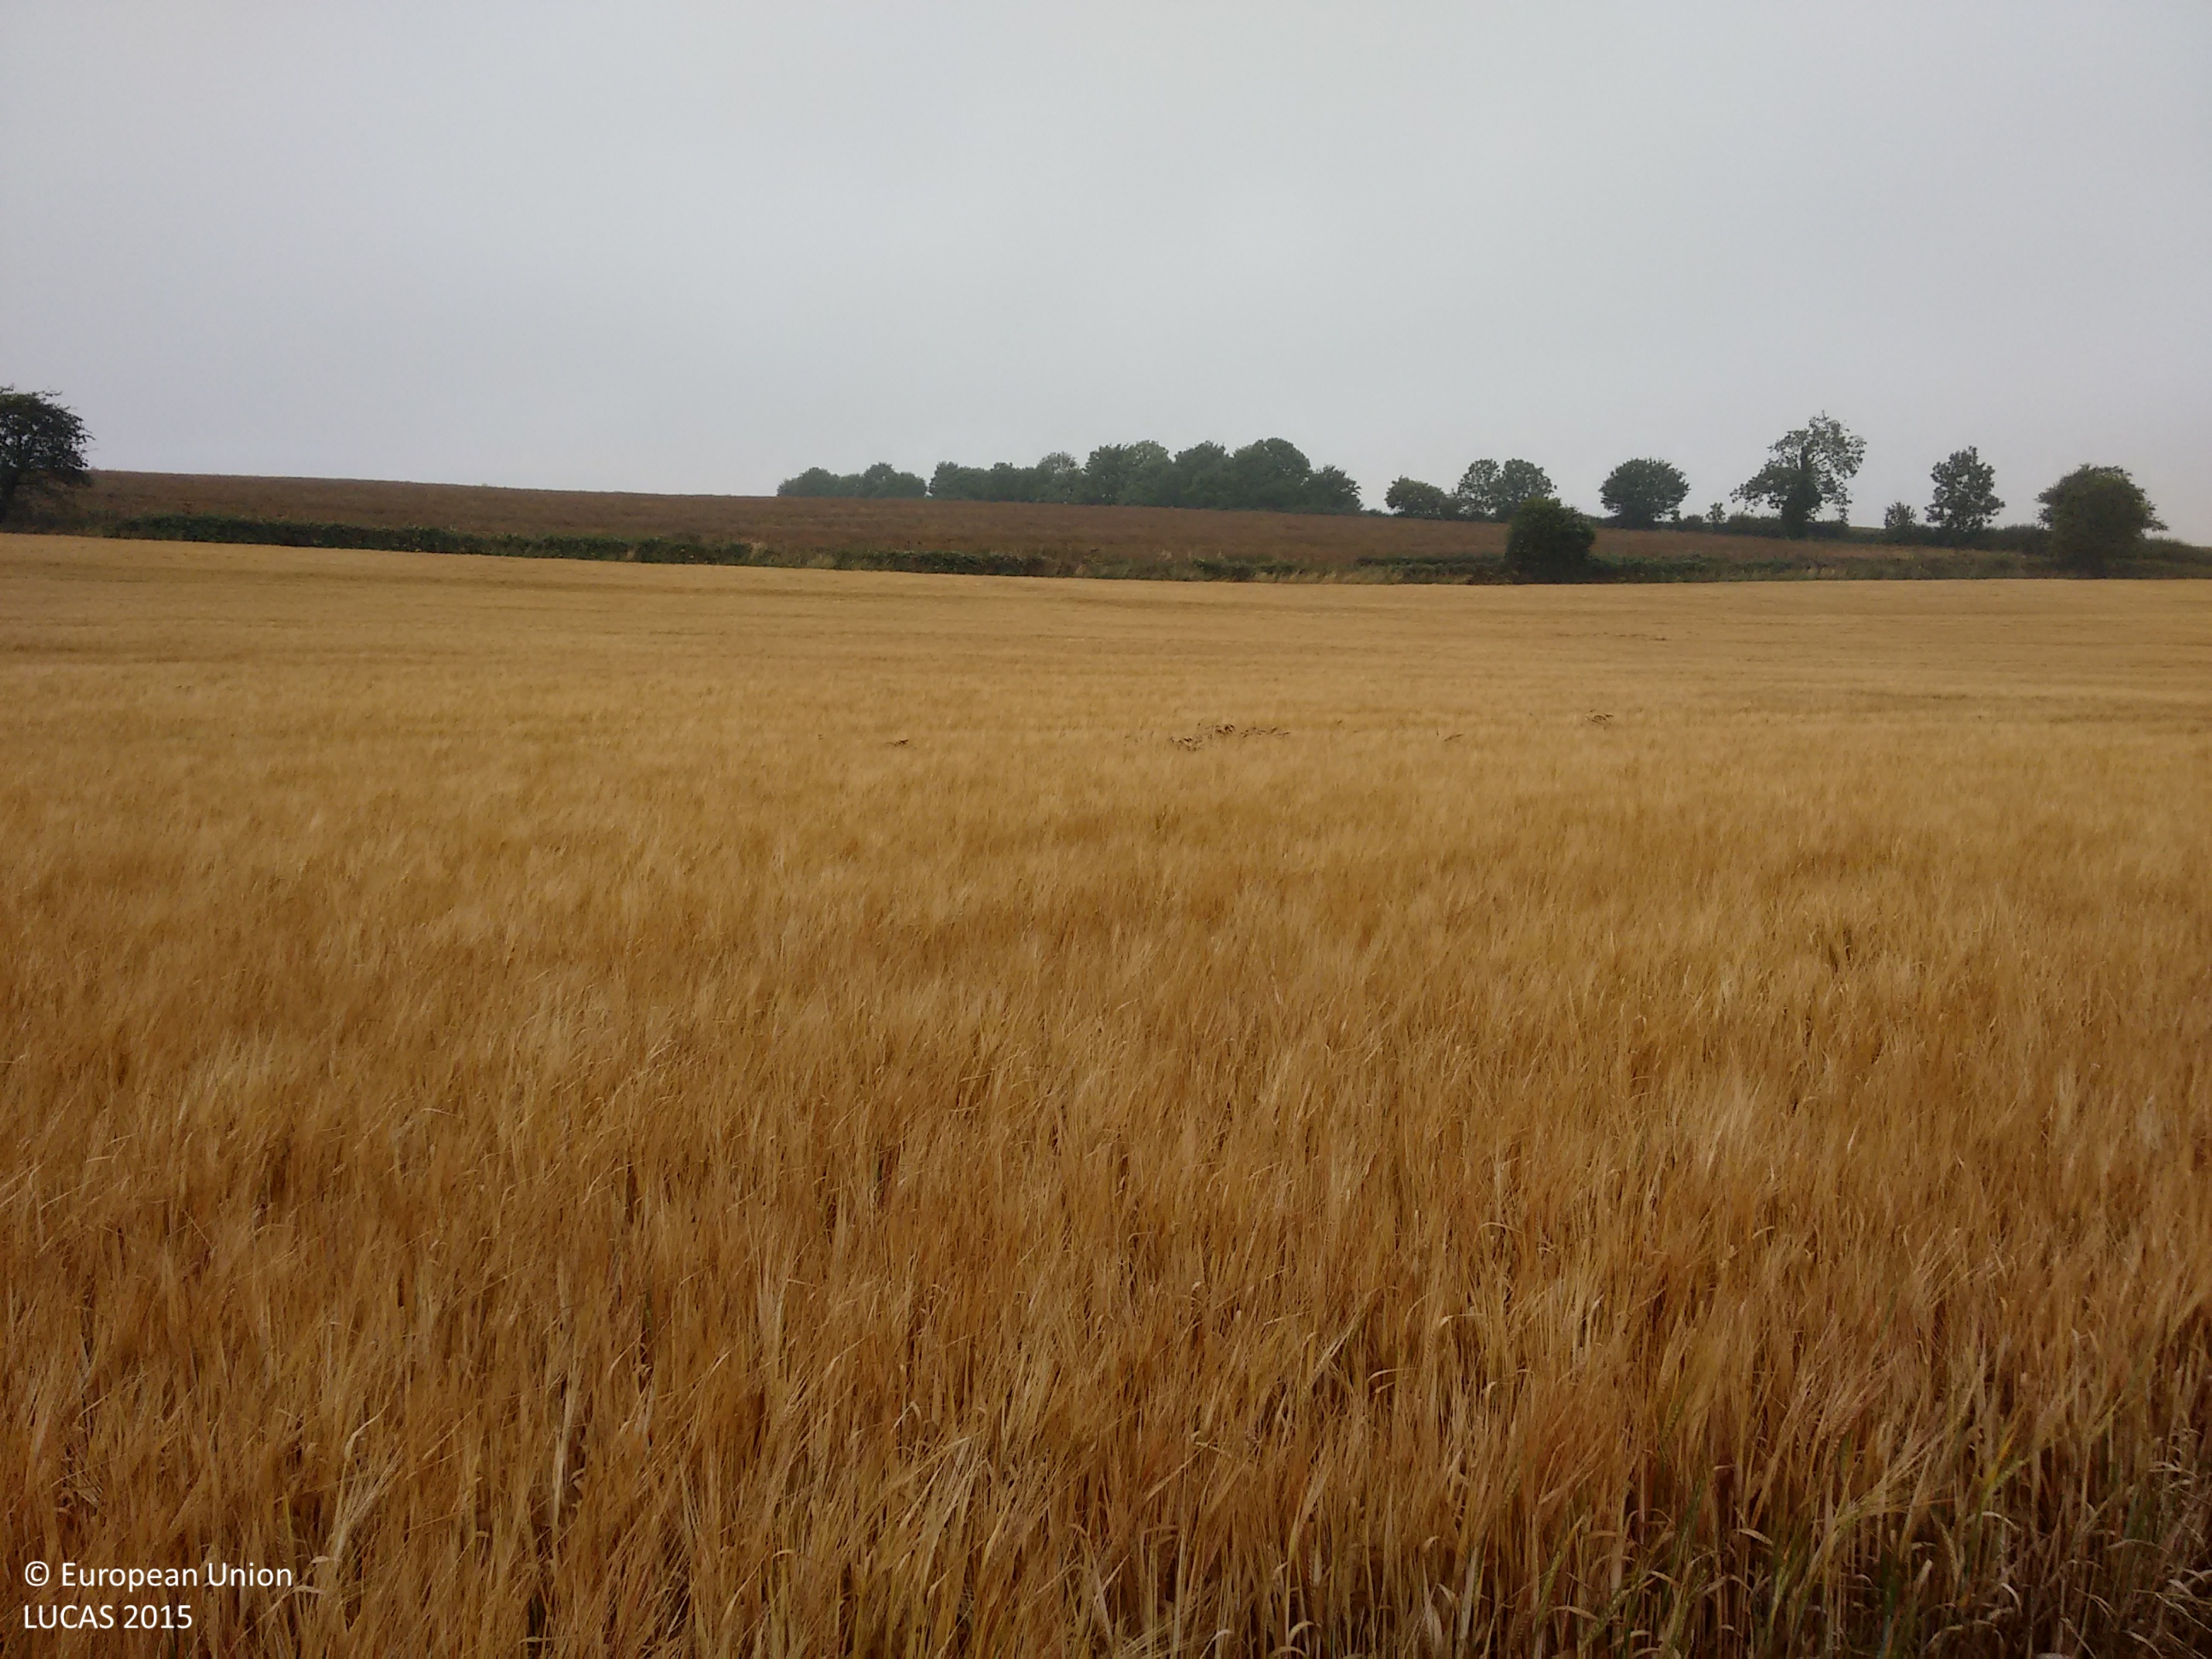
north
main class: Grassland
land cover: Grassland without tree/shrub cover
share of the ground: > 75 %
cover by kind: herbaceous plants 100 %
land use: Agriculture (excluding fallow land and kitchen gardens)
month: July
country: GB
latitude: 50.7589
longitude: -2.2392
